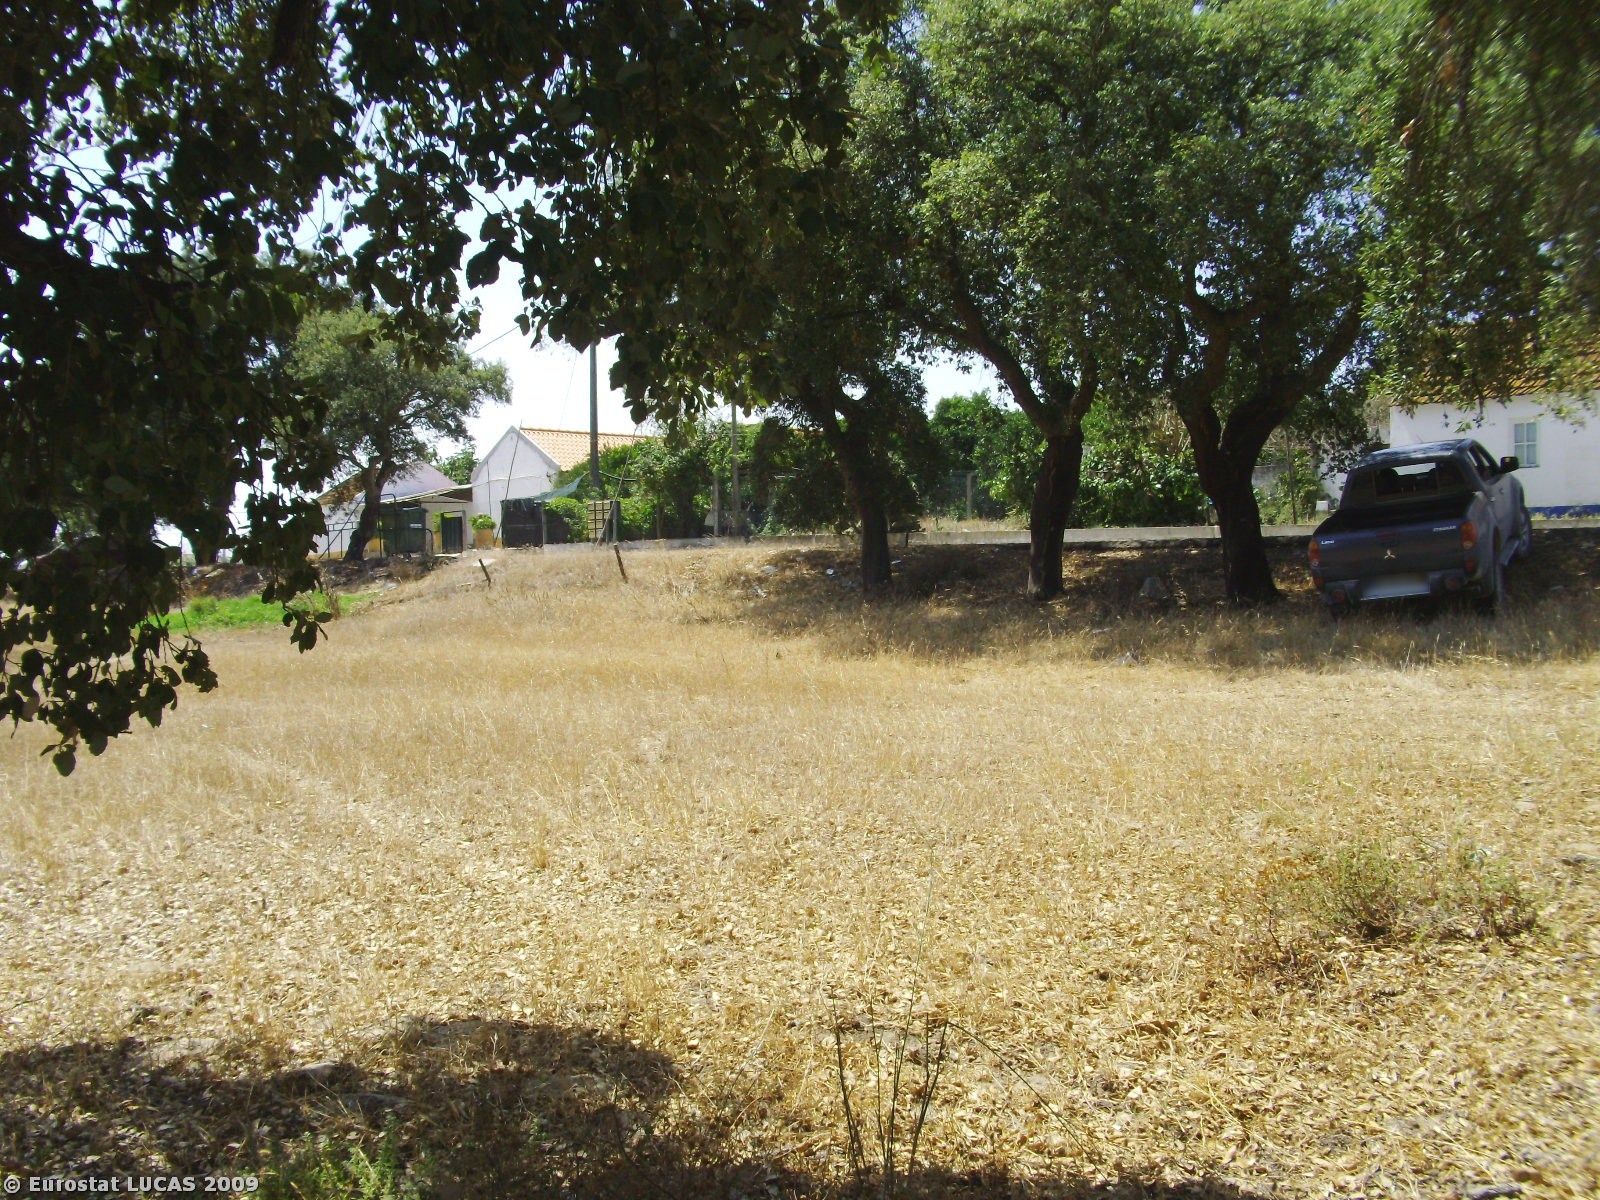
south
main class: Woodland
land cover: Broadleaved woodland
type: broadleaved evergreen forest
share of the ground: 25 - 50 %
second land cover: Bare land
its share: > 75 %
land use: Forestry
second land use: Fallow land
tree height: > 5 m
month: July
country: PT
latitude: 38.5384
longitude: -8.8200
